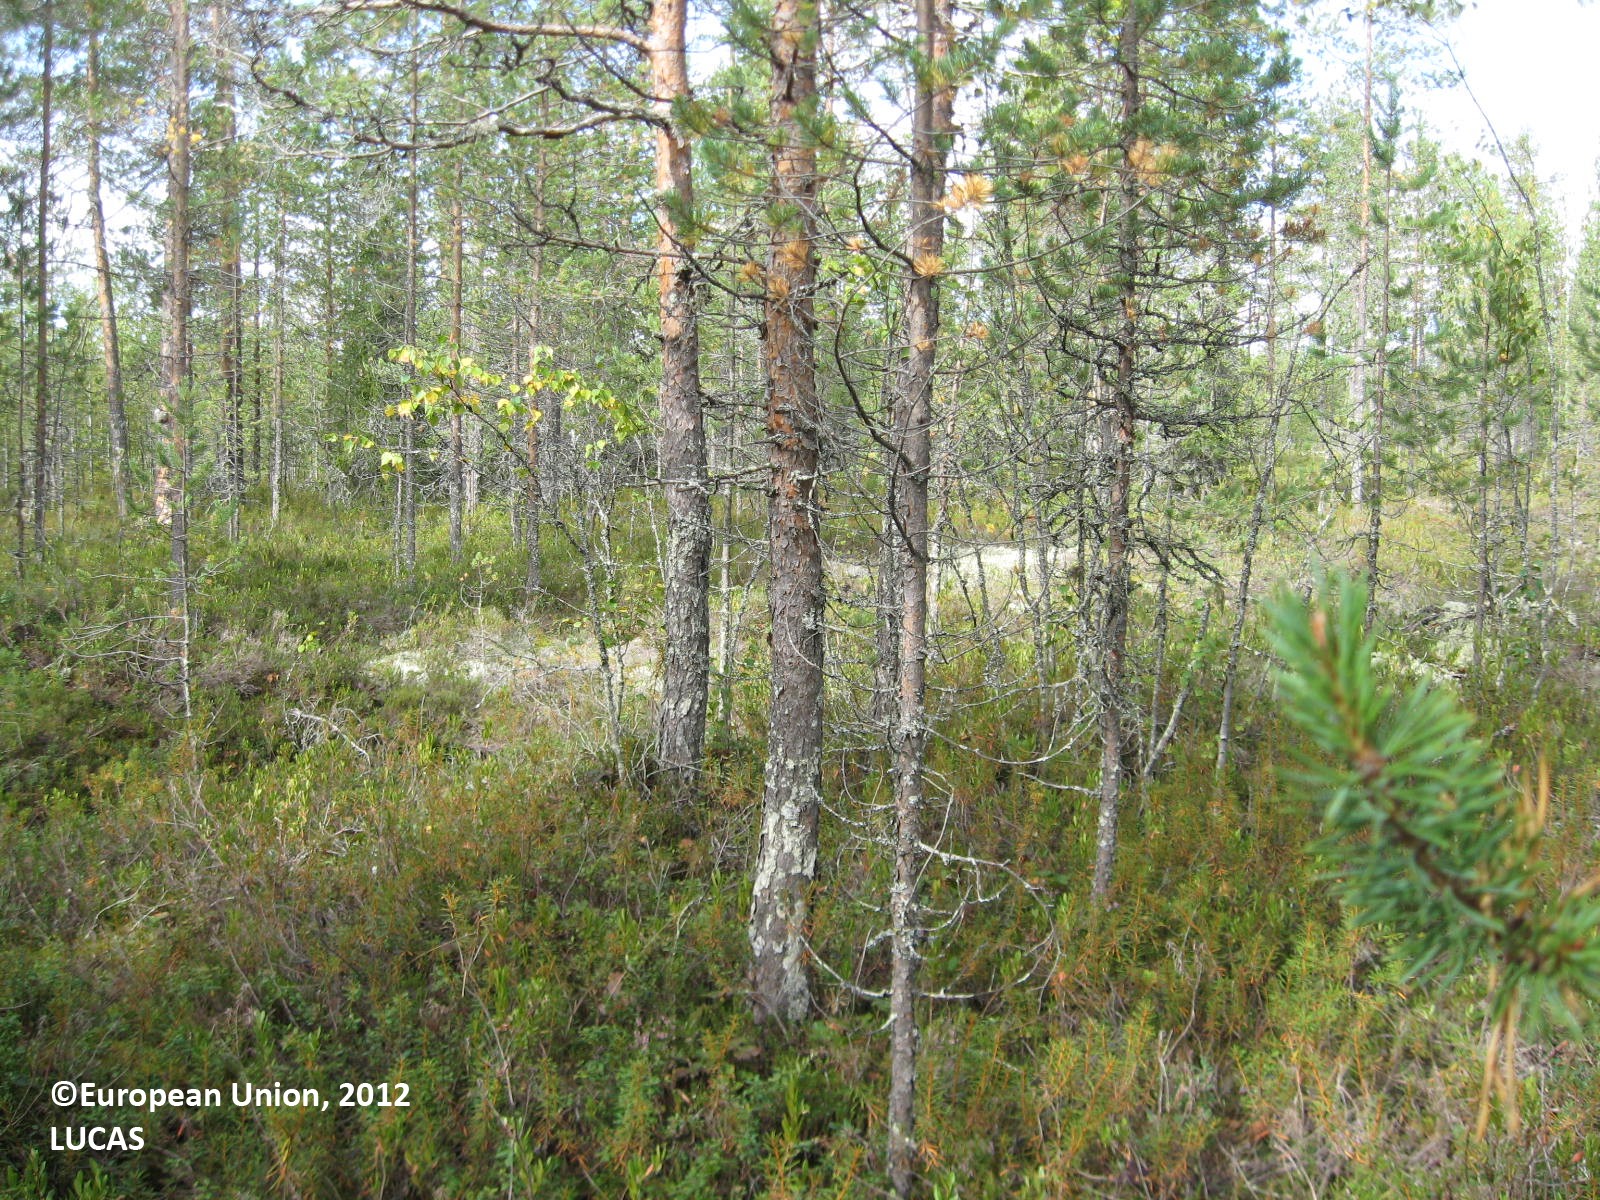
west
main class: Woodland
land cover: Pine dominated coniferous woodland
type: boreal forest
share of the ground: 50 - 75 %
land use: Forestry
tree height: > 5 m
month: August
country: FI
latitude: 63.6654
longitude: 29.5634
